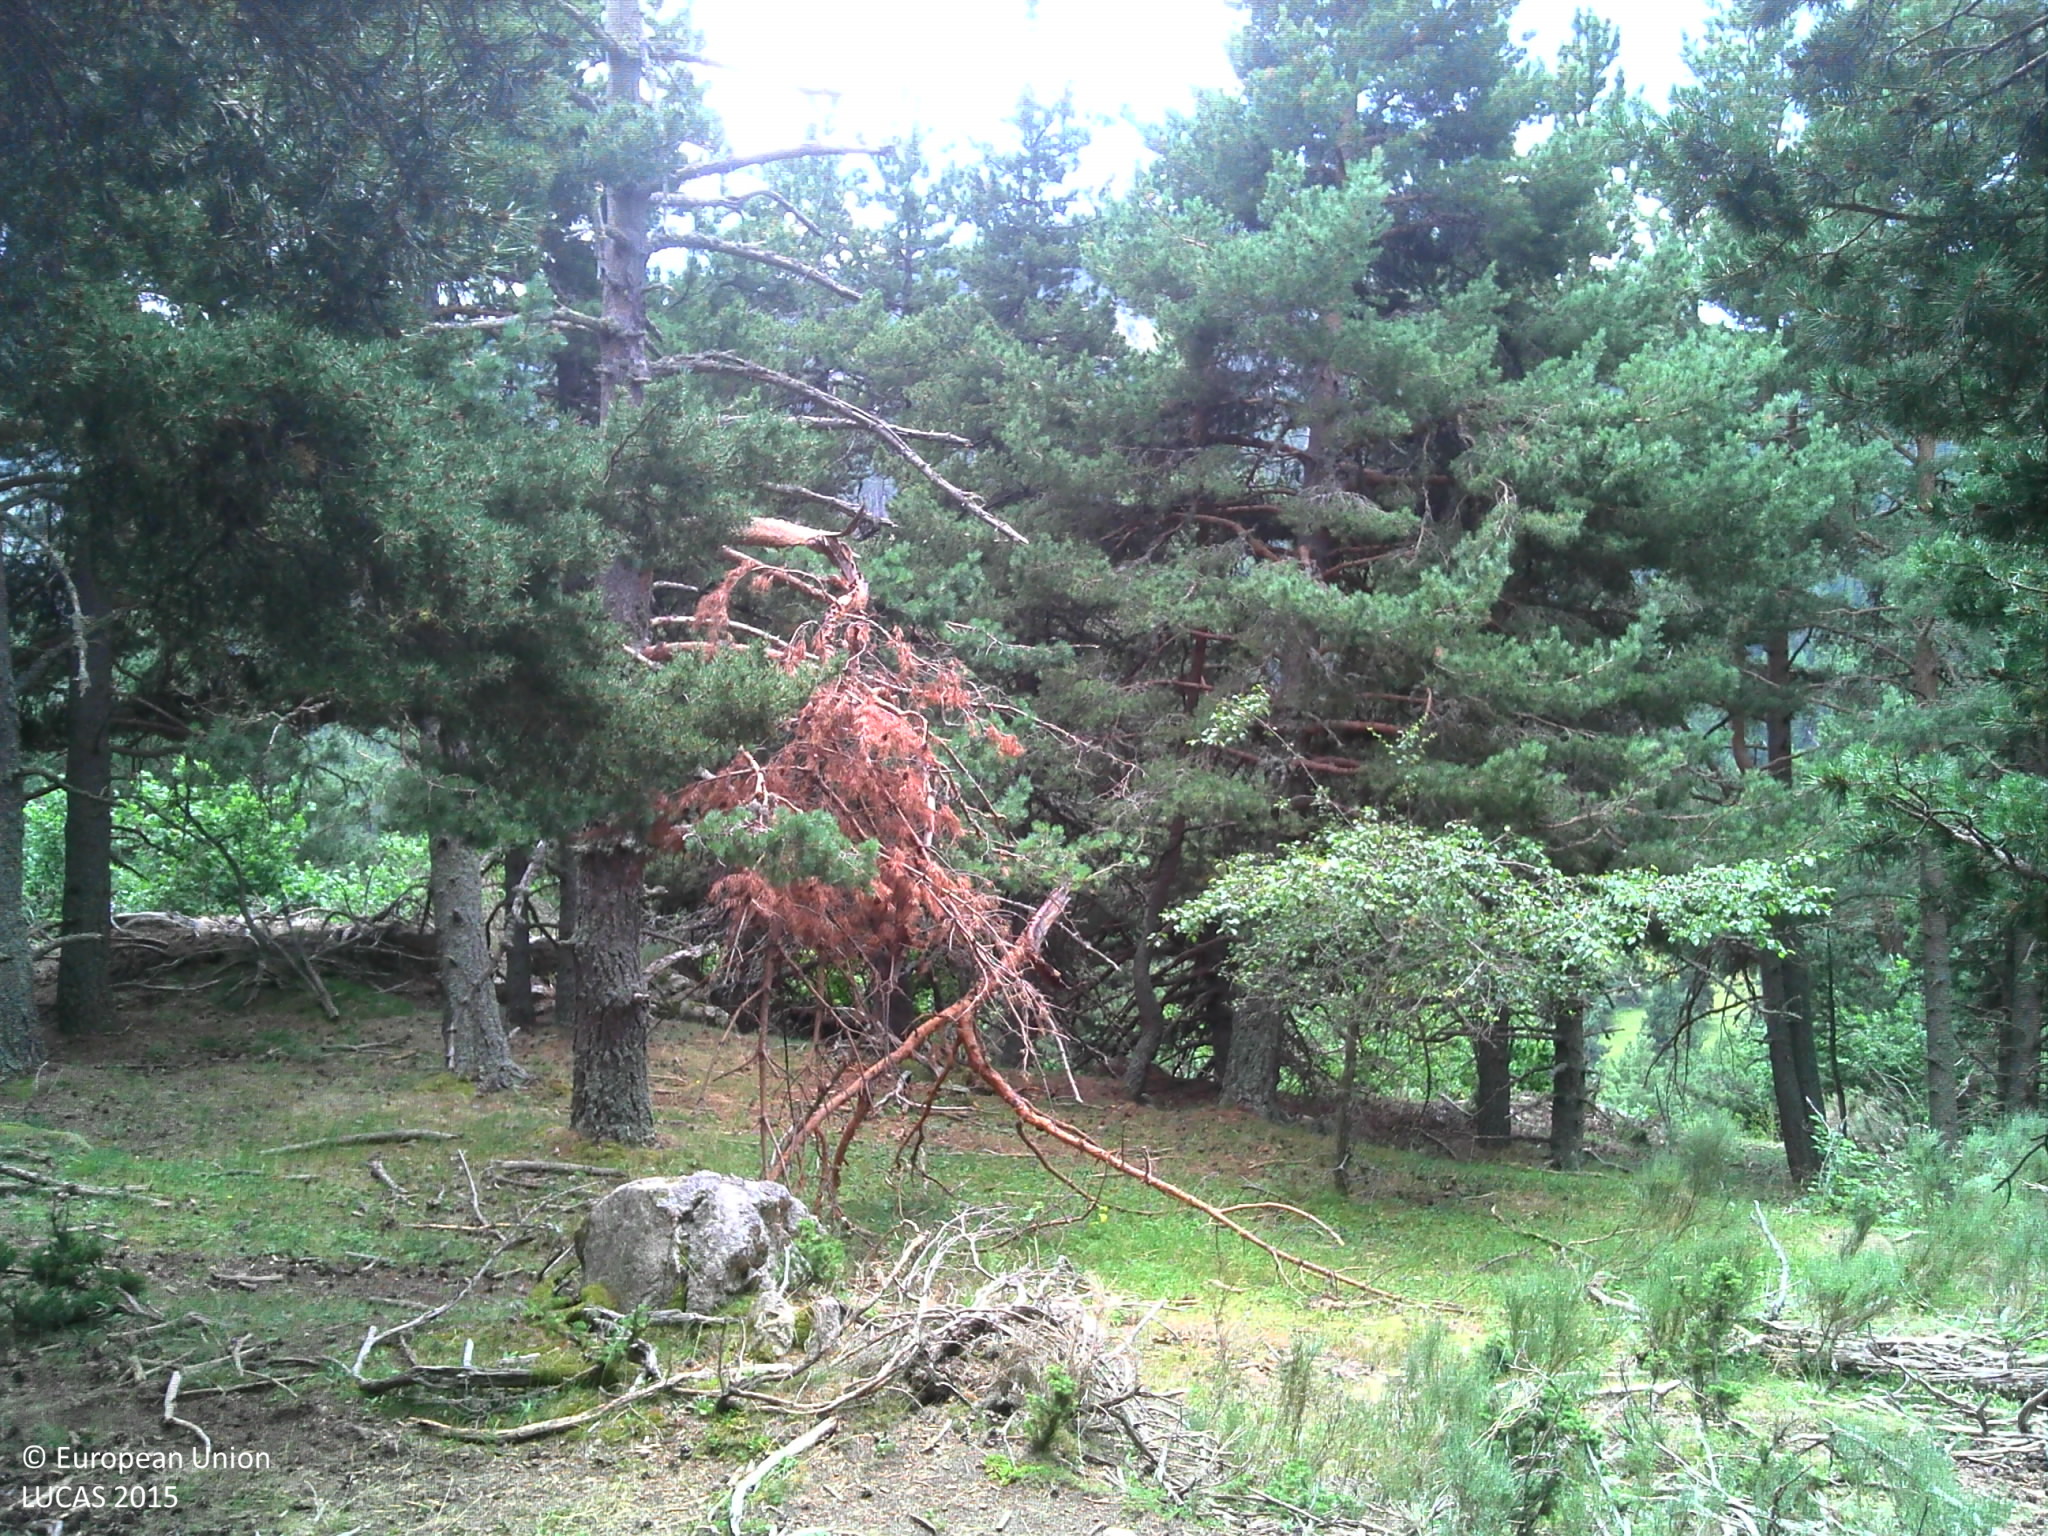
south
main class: Woodland
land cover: Pine dominated coniferous woodland
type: hemiboreal forest and nemoral coniferous forest and mixed broadleaved-coniferous forest
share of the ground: > 75 %
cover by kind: coniferous forest trees 80 %, shrubs 10 %, herbaceous plants 10 %
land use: Agriculture (excluding fallow land and kitchen gardens)
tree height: > 5 m
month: July
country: FR
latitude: 42.6029
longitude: 2.1492
